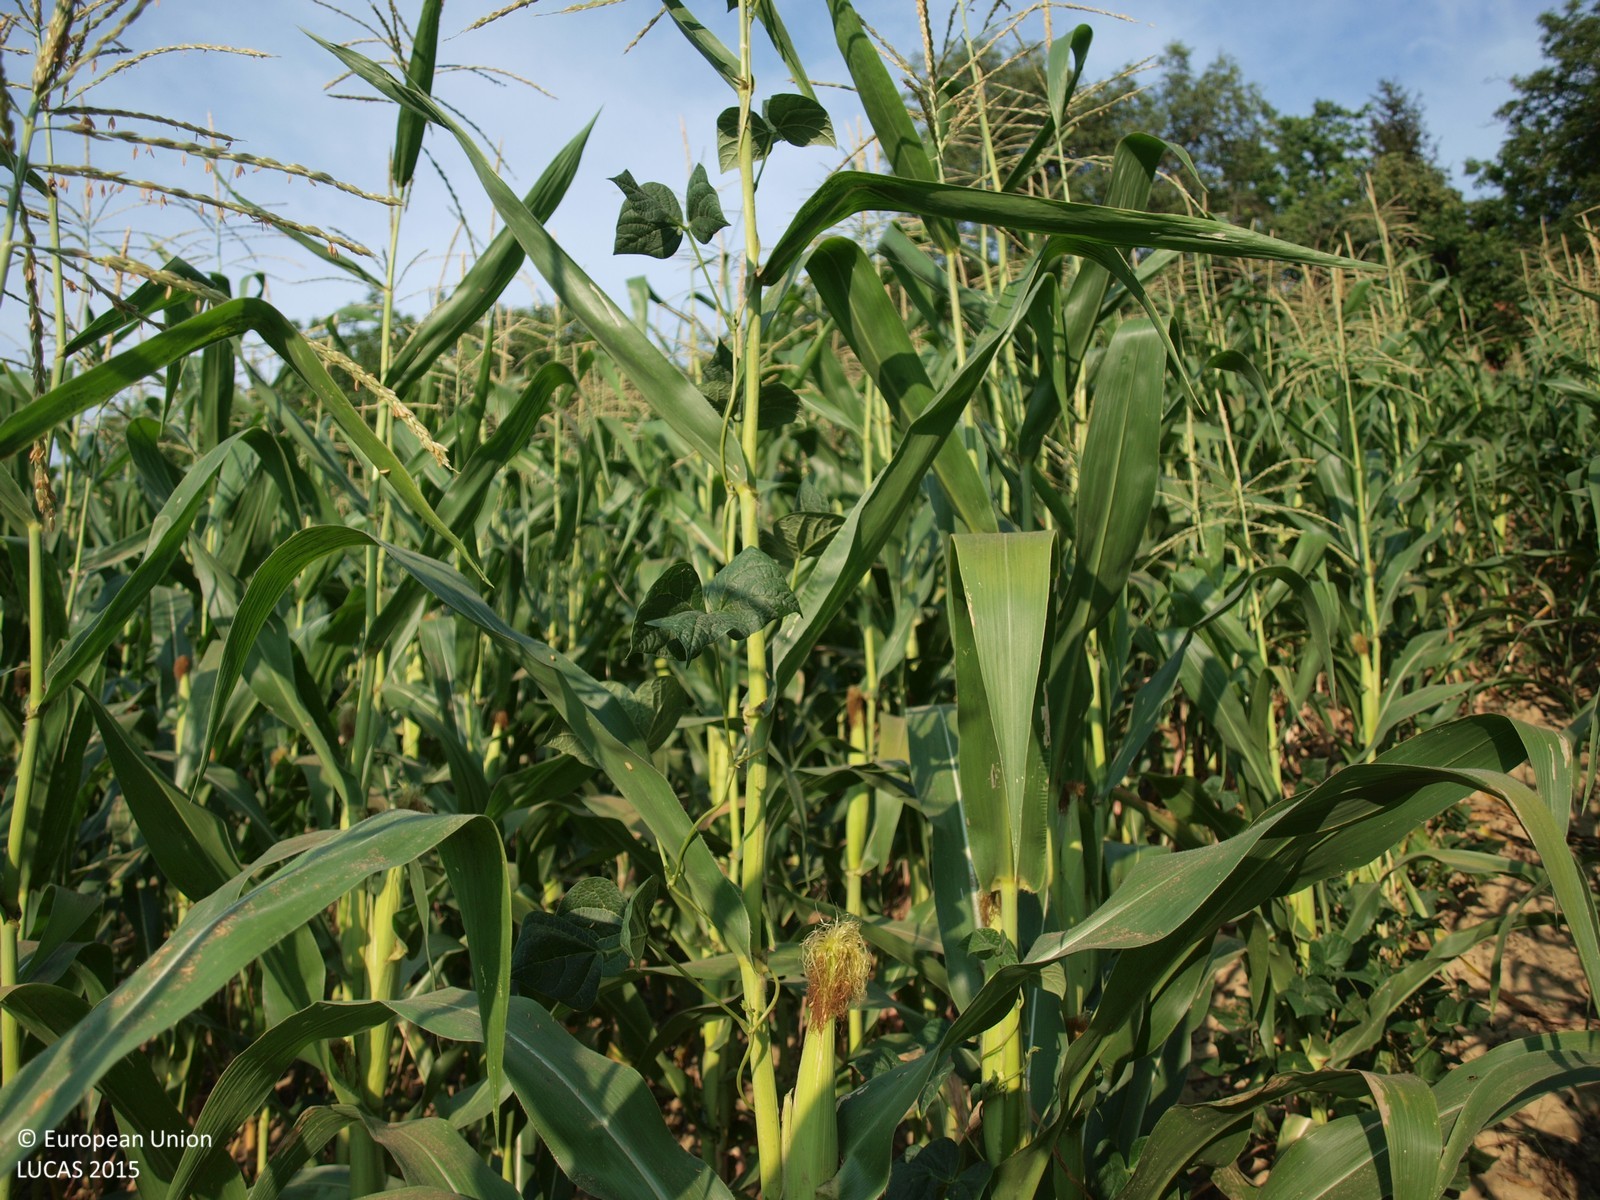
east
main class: Cropland
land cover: Maize
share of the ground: > 75 %
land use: Agriculture (excluding fallow land and kitchen gardens)
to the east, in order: Maize; Grassland without tree/shrub cover; Fences; Artificial constructions in urban areas; Paved roads, cycling and walking lanes; Electric lines; Grassland without tree/shrub cover; Lucerne; Grassland without tree/shrub cover; Other fresh vegetables
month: July
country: HR
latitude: 45.9184
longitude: 16.2005
